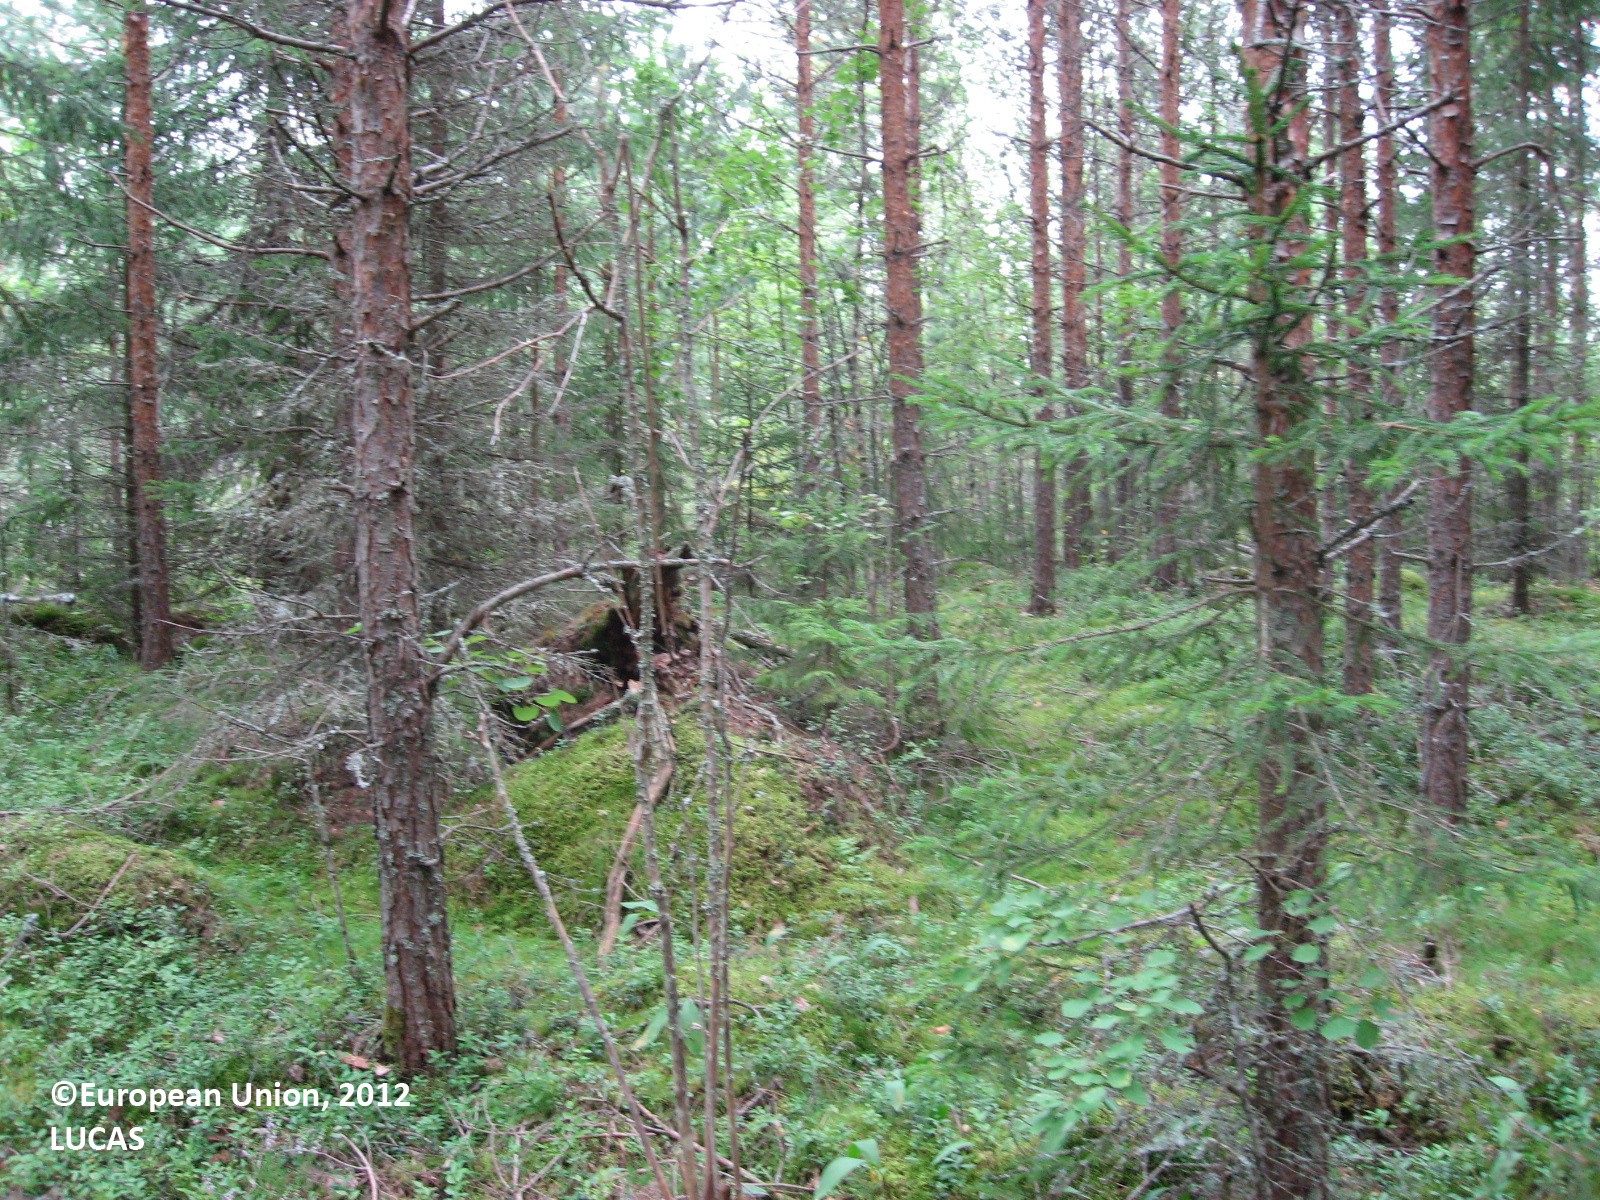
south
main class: Woodland
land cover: Pine dominated coniferous woodland
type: boreal forest
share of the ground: > 75 %
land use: Forestry
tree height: > 5 m
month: August
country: FI
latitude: 60.7280
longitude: 25.5480
